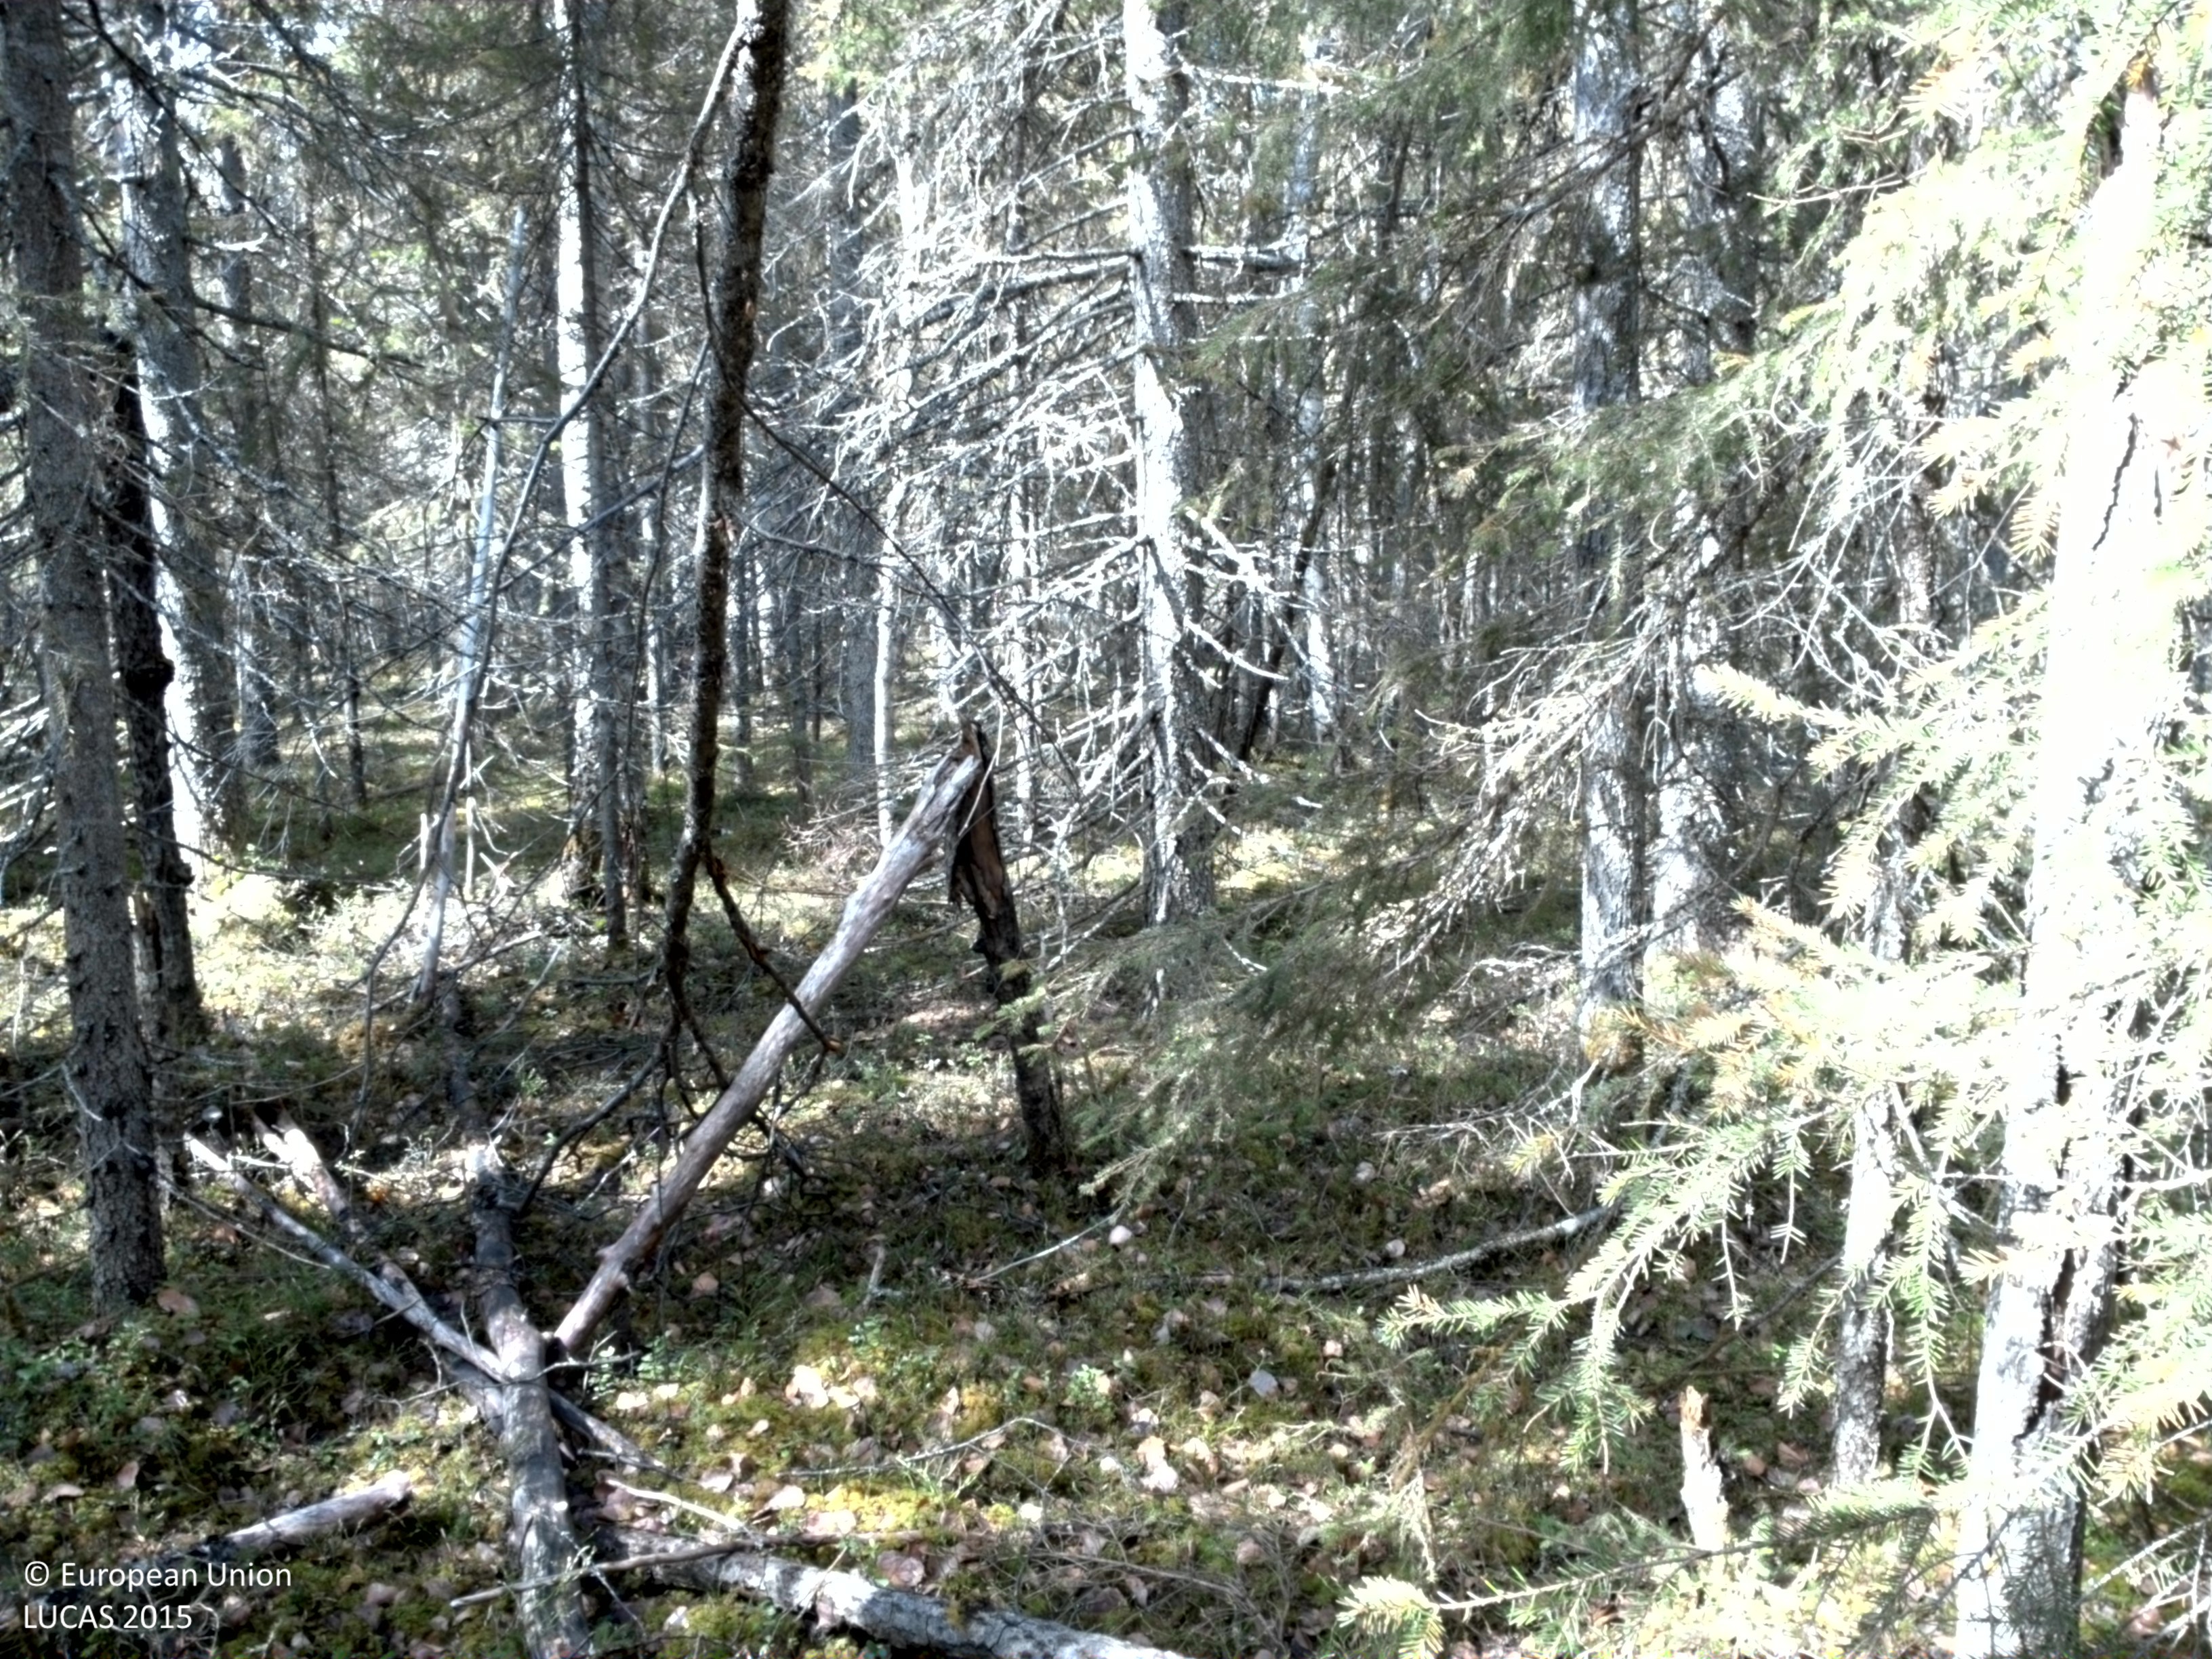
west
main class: Woodland
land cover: Spruce dominated coniferous woodland
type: boreal forest
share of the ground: > 75 %
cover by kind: coniferous forest trees 85 %, shrubs 10 %, broadleaved forest trees 5 %
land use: Forestry
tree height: > 5 m
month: May
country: SE
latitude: 66.1410
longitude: 23.2120
